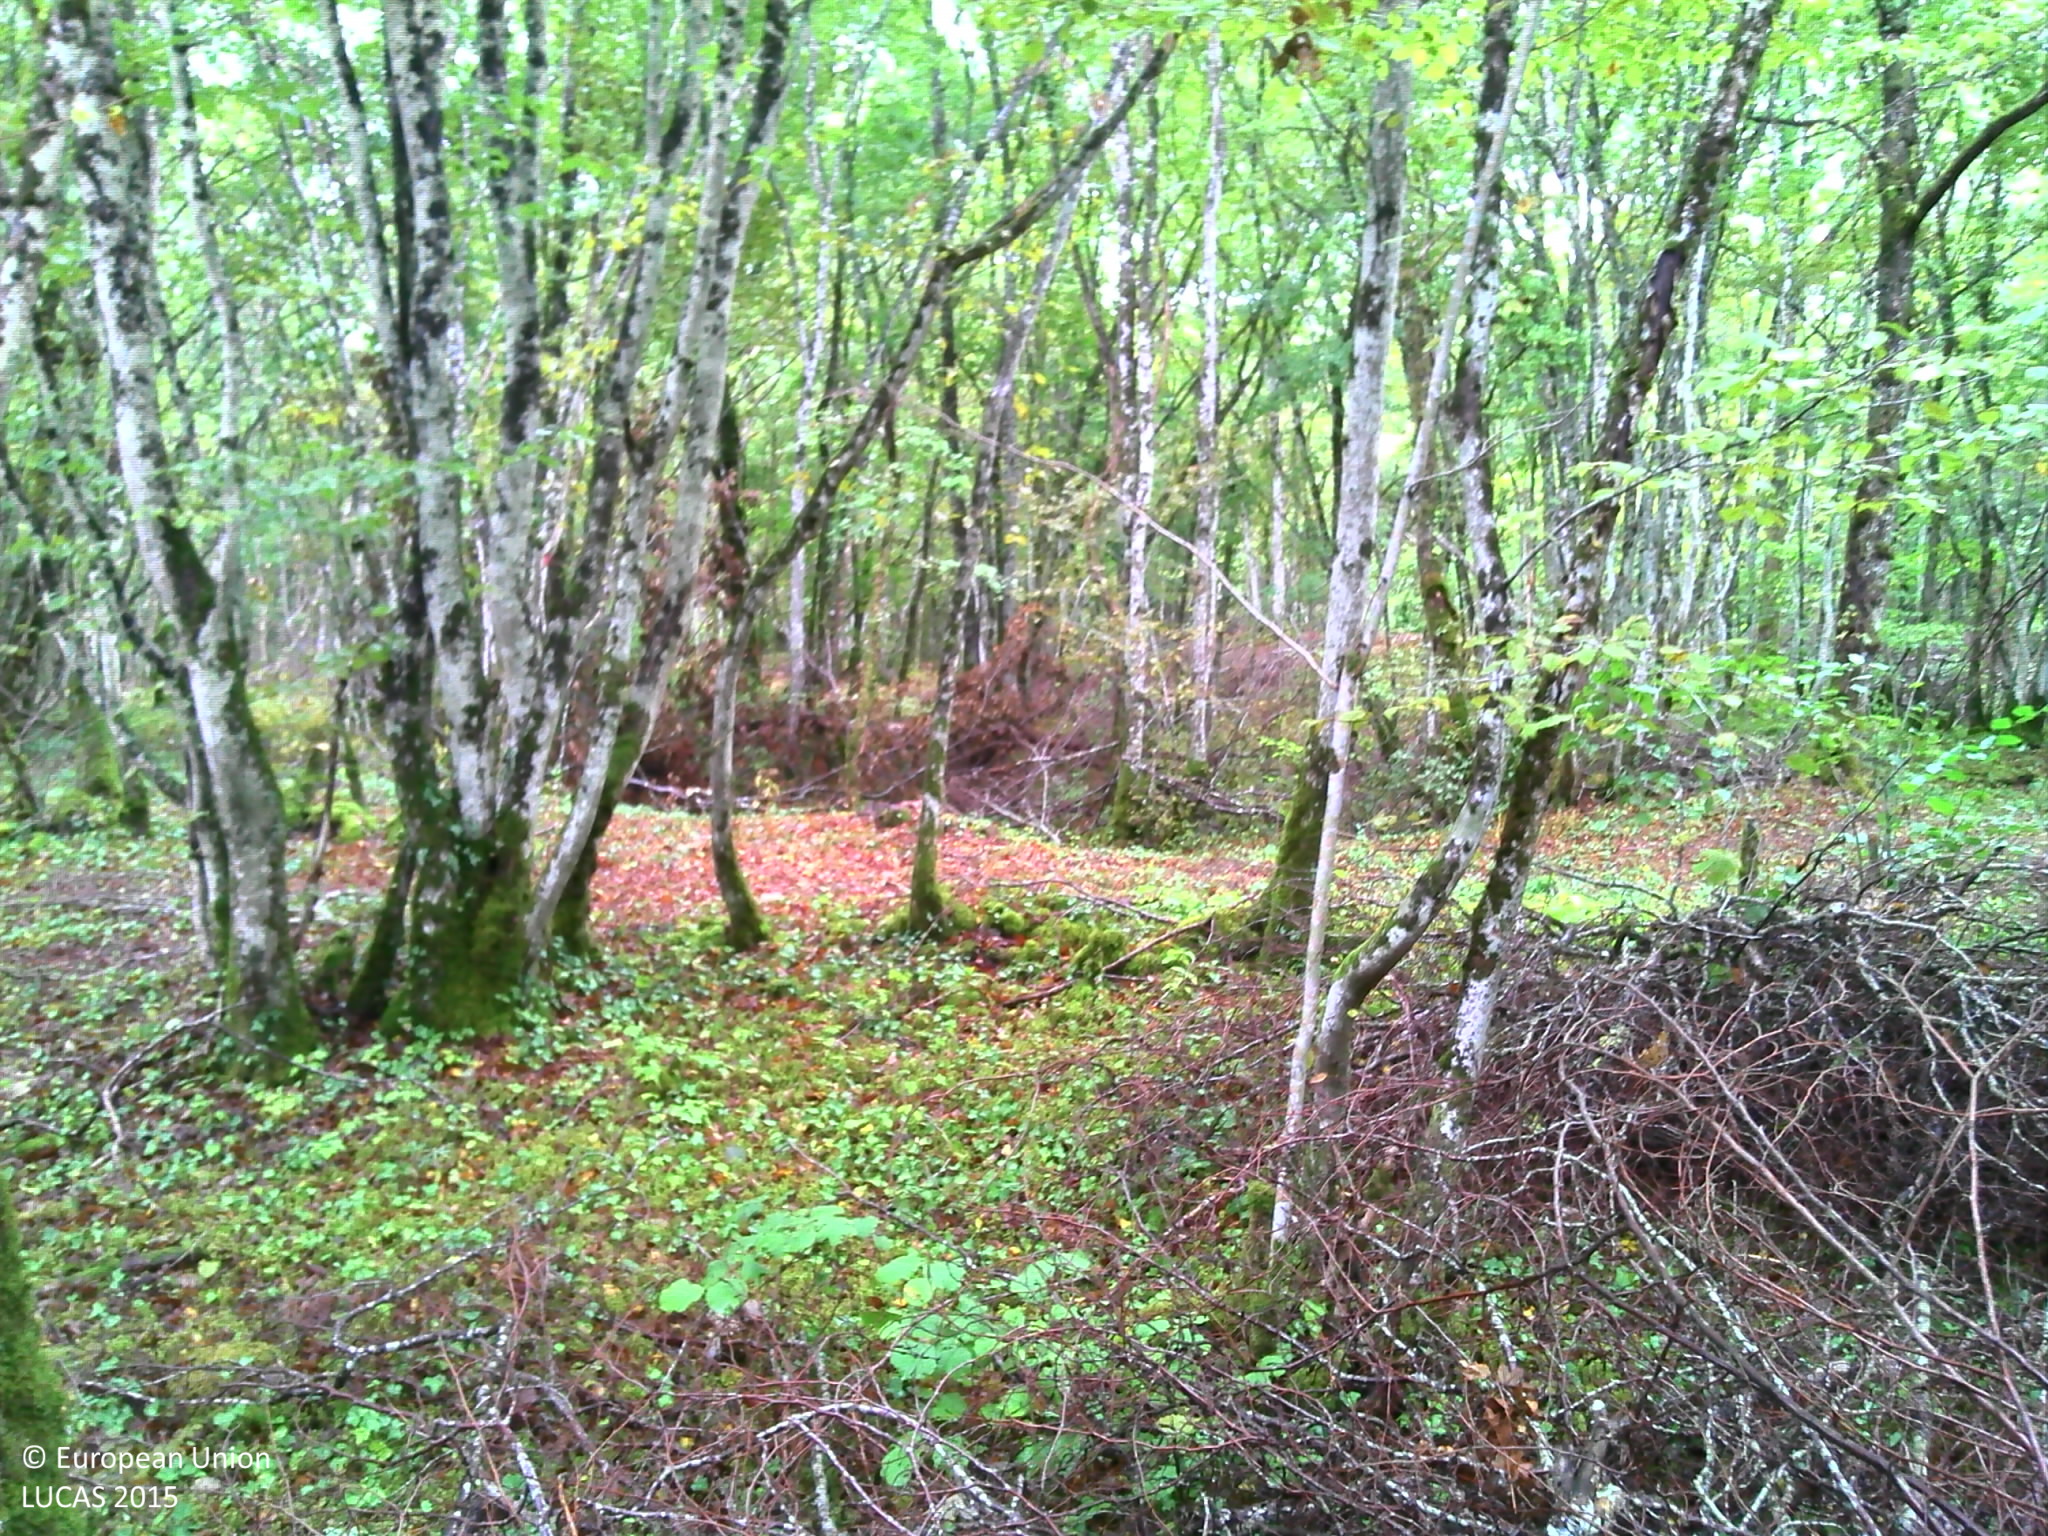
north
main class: Woodland
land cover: Broadleaved woodland
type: mesophytic deciduous forest
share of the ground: > 75 %
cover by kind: broadleaved forest trees 85 %, herbaceous plants 15 %
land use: Forestry
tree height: > 5 m
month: September
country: FR
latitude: 47.3747
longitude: 4.3439
